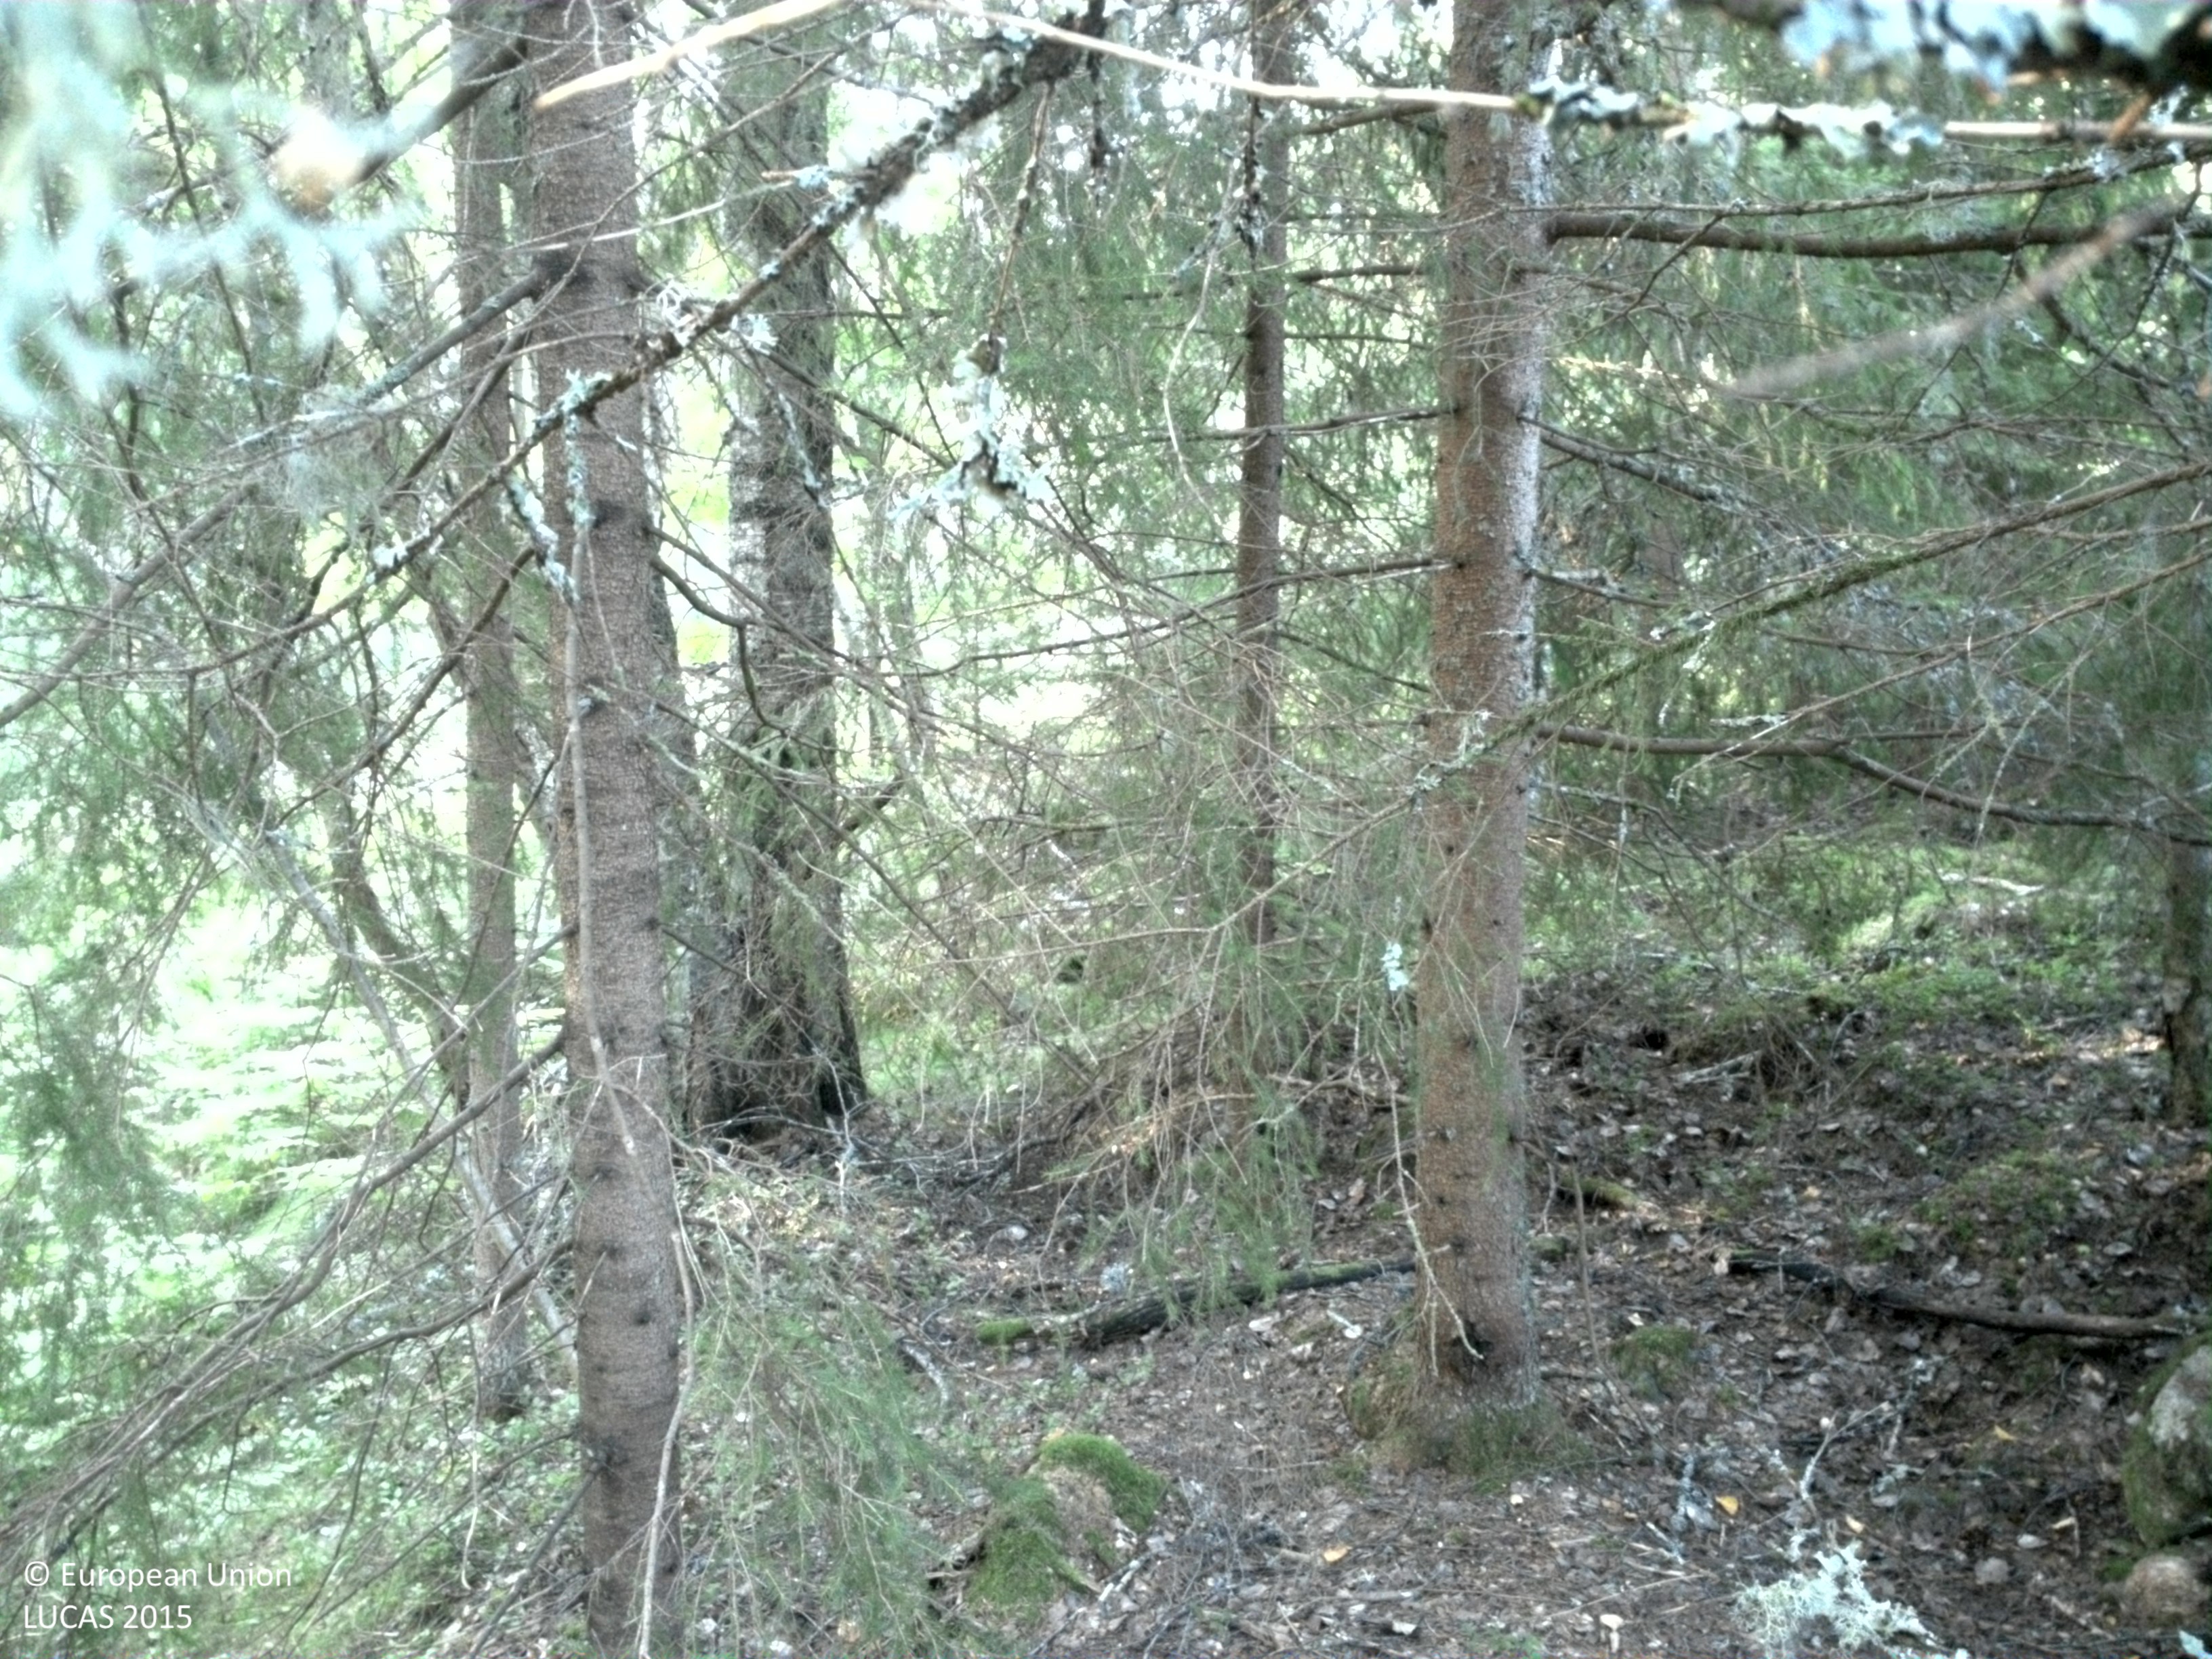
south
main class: Woodland
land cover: Spruce dominated mixed woodland
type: boreal forest
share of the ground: 50 - 75 %
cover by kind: coniferous forest trees 40 %, broadleaved forest trees 30 %, shrubs 15 %, herbaceous plants 15 %
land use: Forestry
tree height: > 5 m
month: August
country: SE
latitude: 59.8437
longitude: 15.8259
